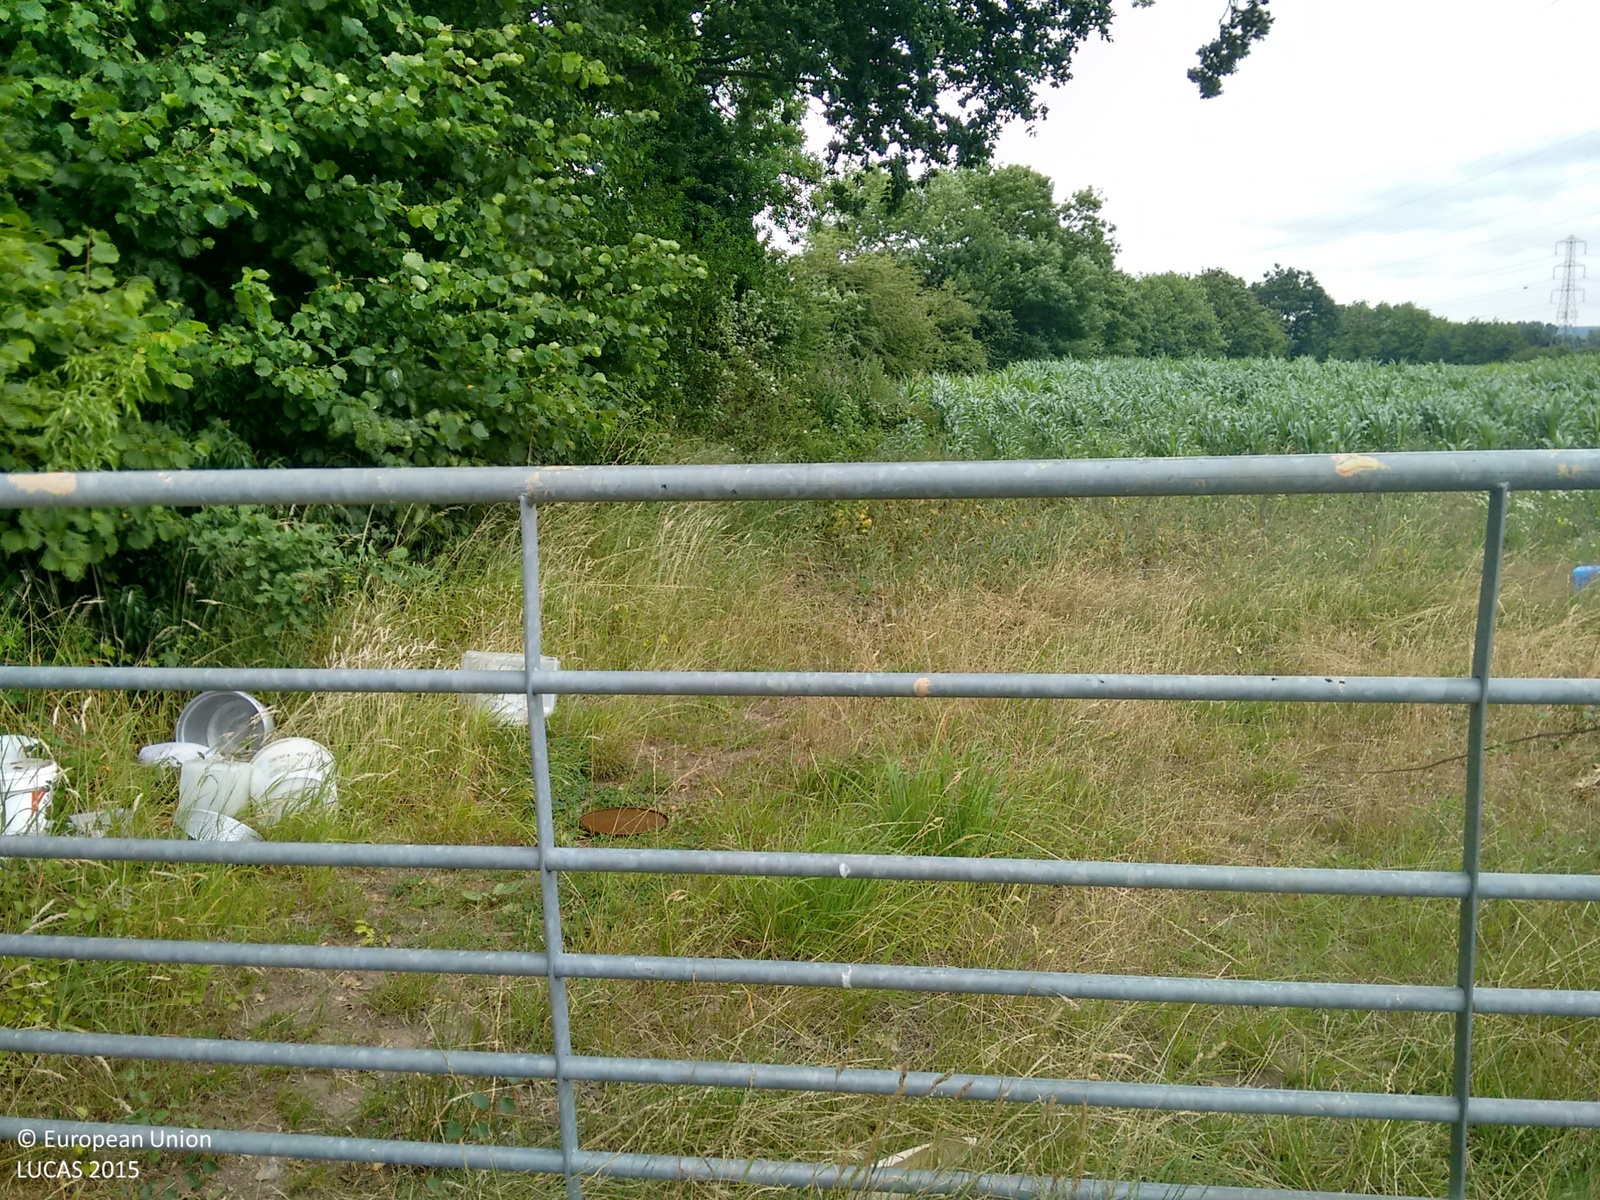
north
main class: Cropland
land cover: Maize
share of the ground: > 75 %
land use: Agriculture (excluding fallow land and kitchen gardens)
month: July
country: GB
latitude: 52.4309
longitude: -1.7173
